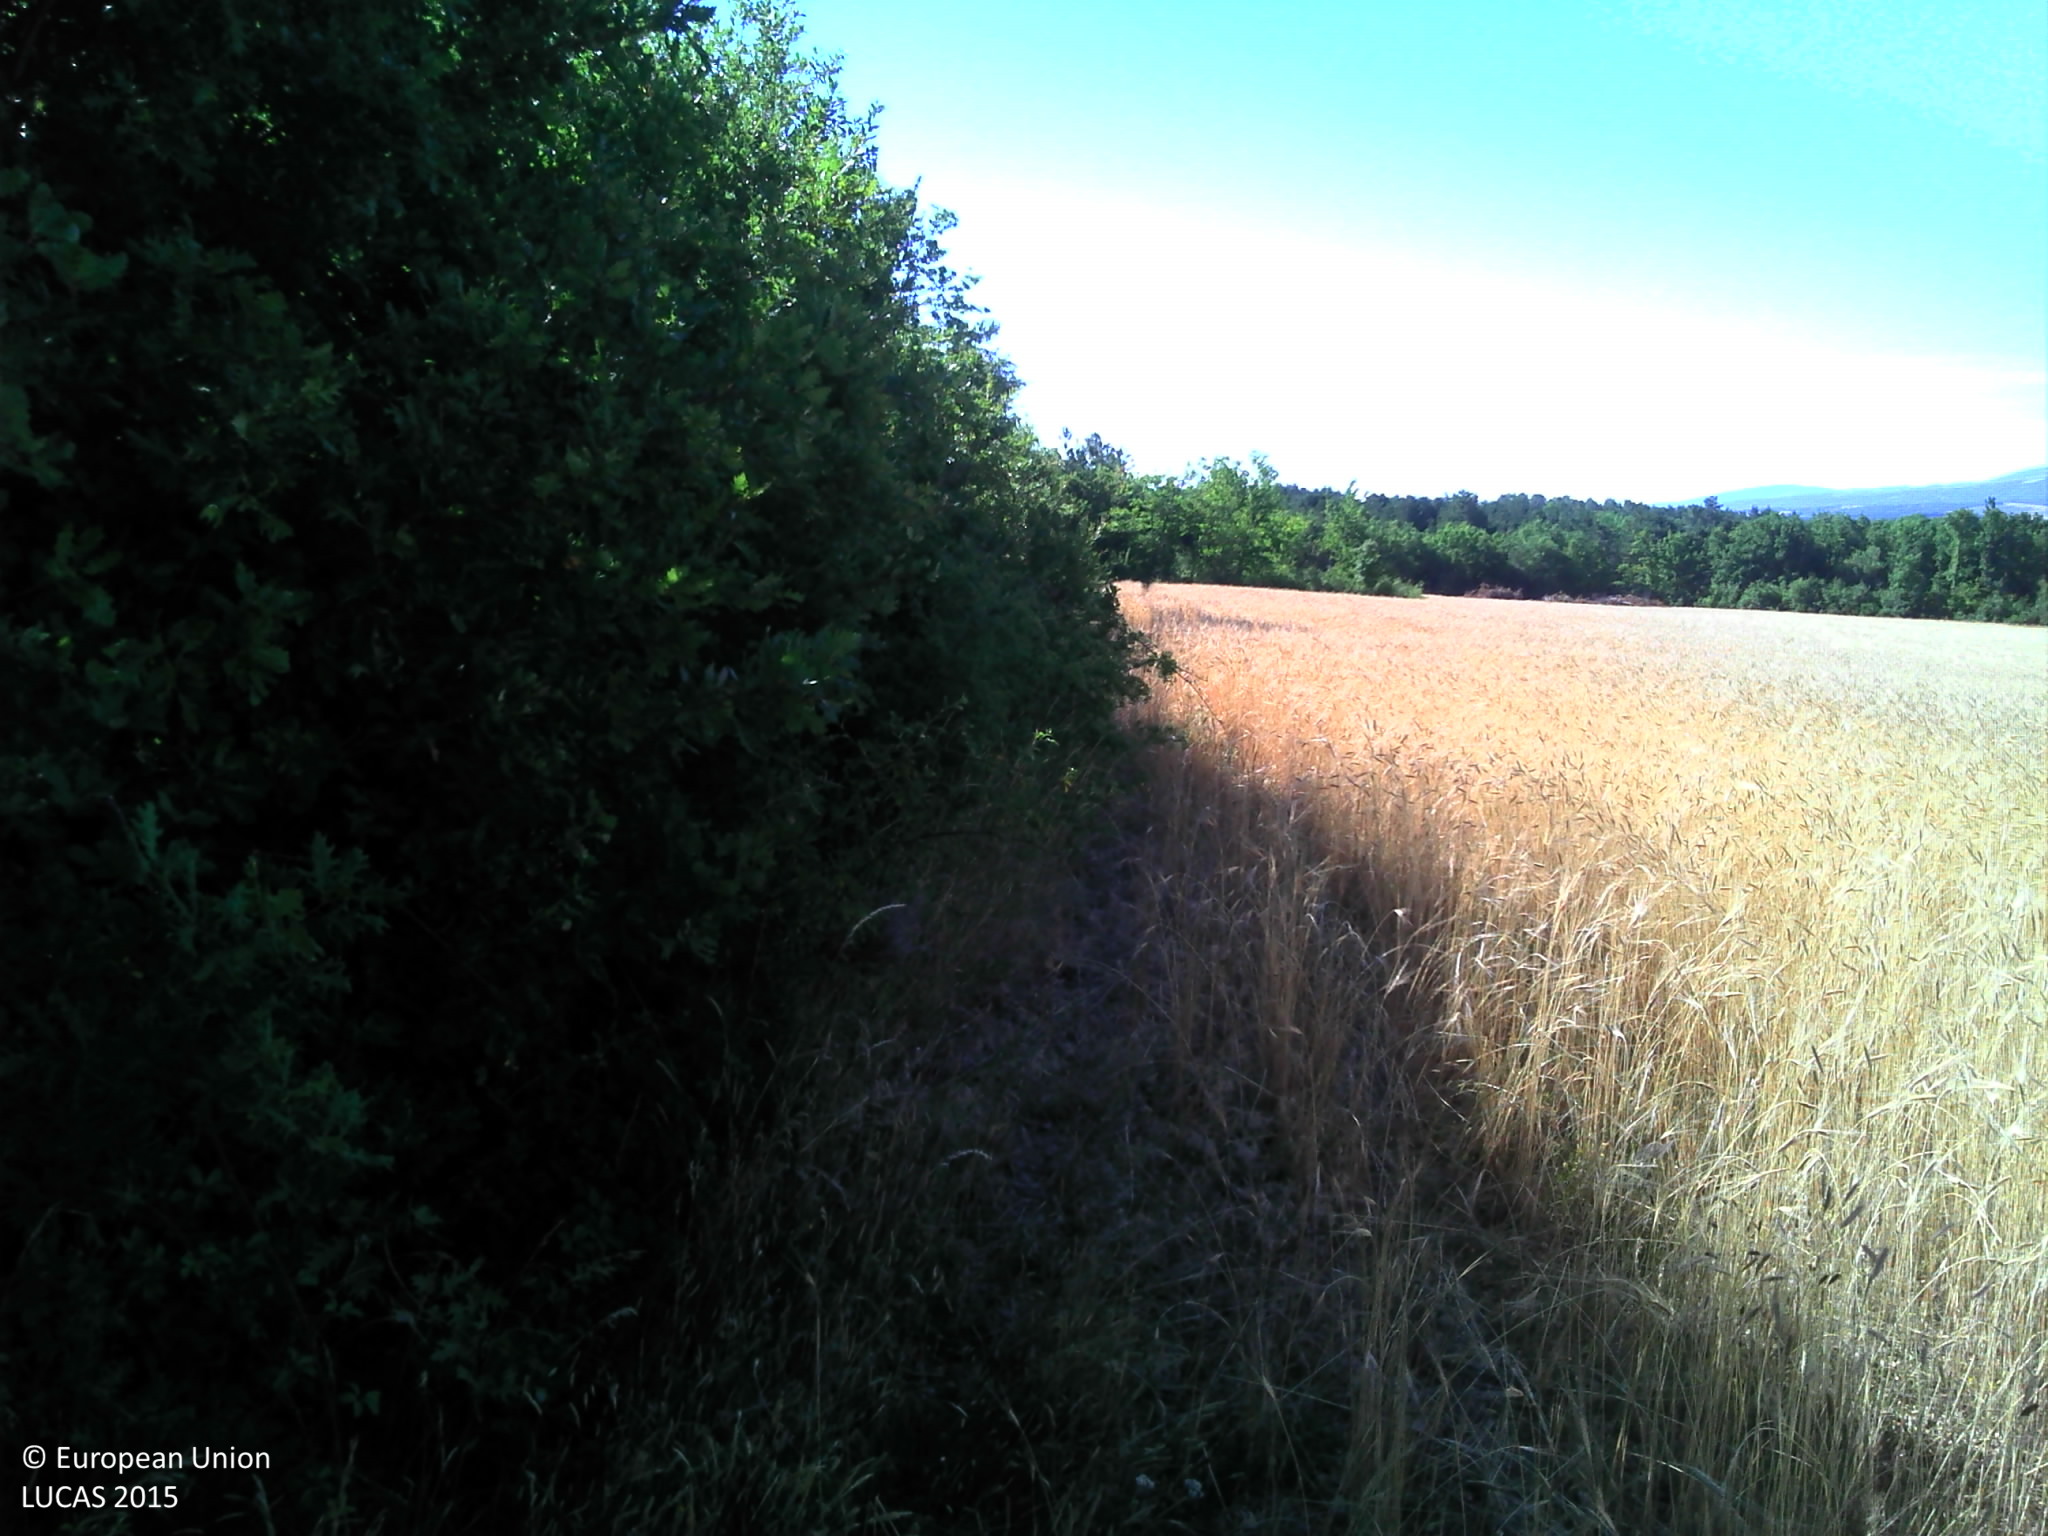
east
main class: Cropland
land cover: Barley
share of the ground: > 75 %
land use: Agriculture (excluding fallow land and kitchen gardens)
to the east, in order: Barley; Broadleaved woodland; Permanent industrial crops; Shrubland with sparse tree cover; Pine dominated mixed woodland; Tracks; Pine dominated mixed woodland; Broadleaved woodland
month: July
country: FR
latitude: 44.1242
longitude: 5.4466
